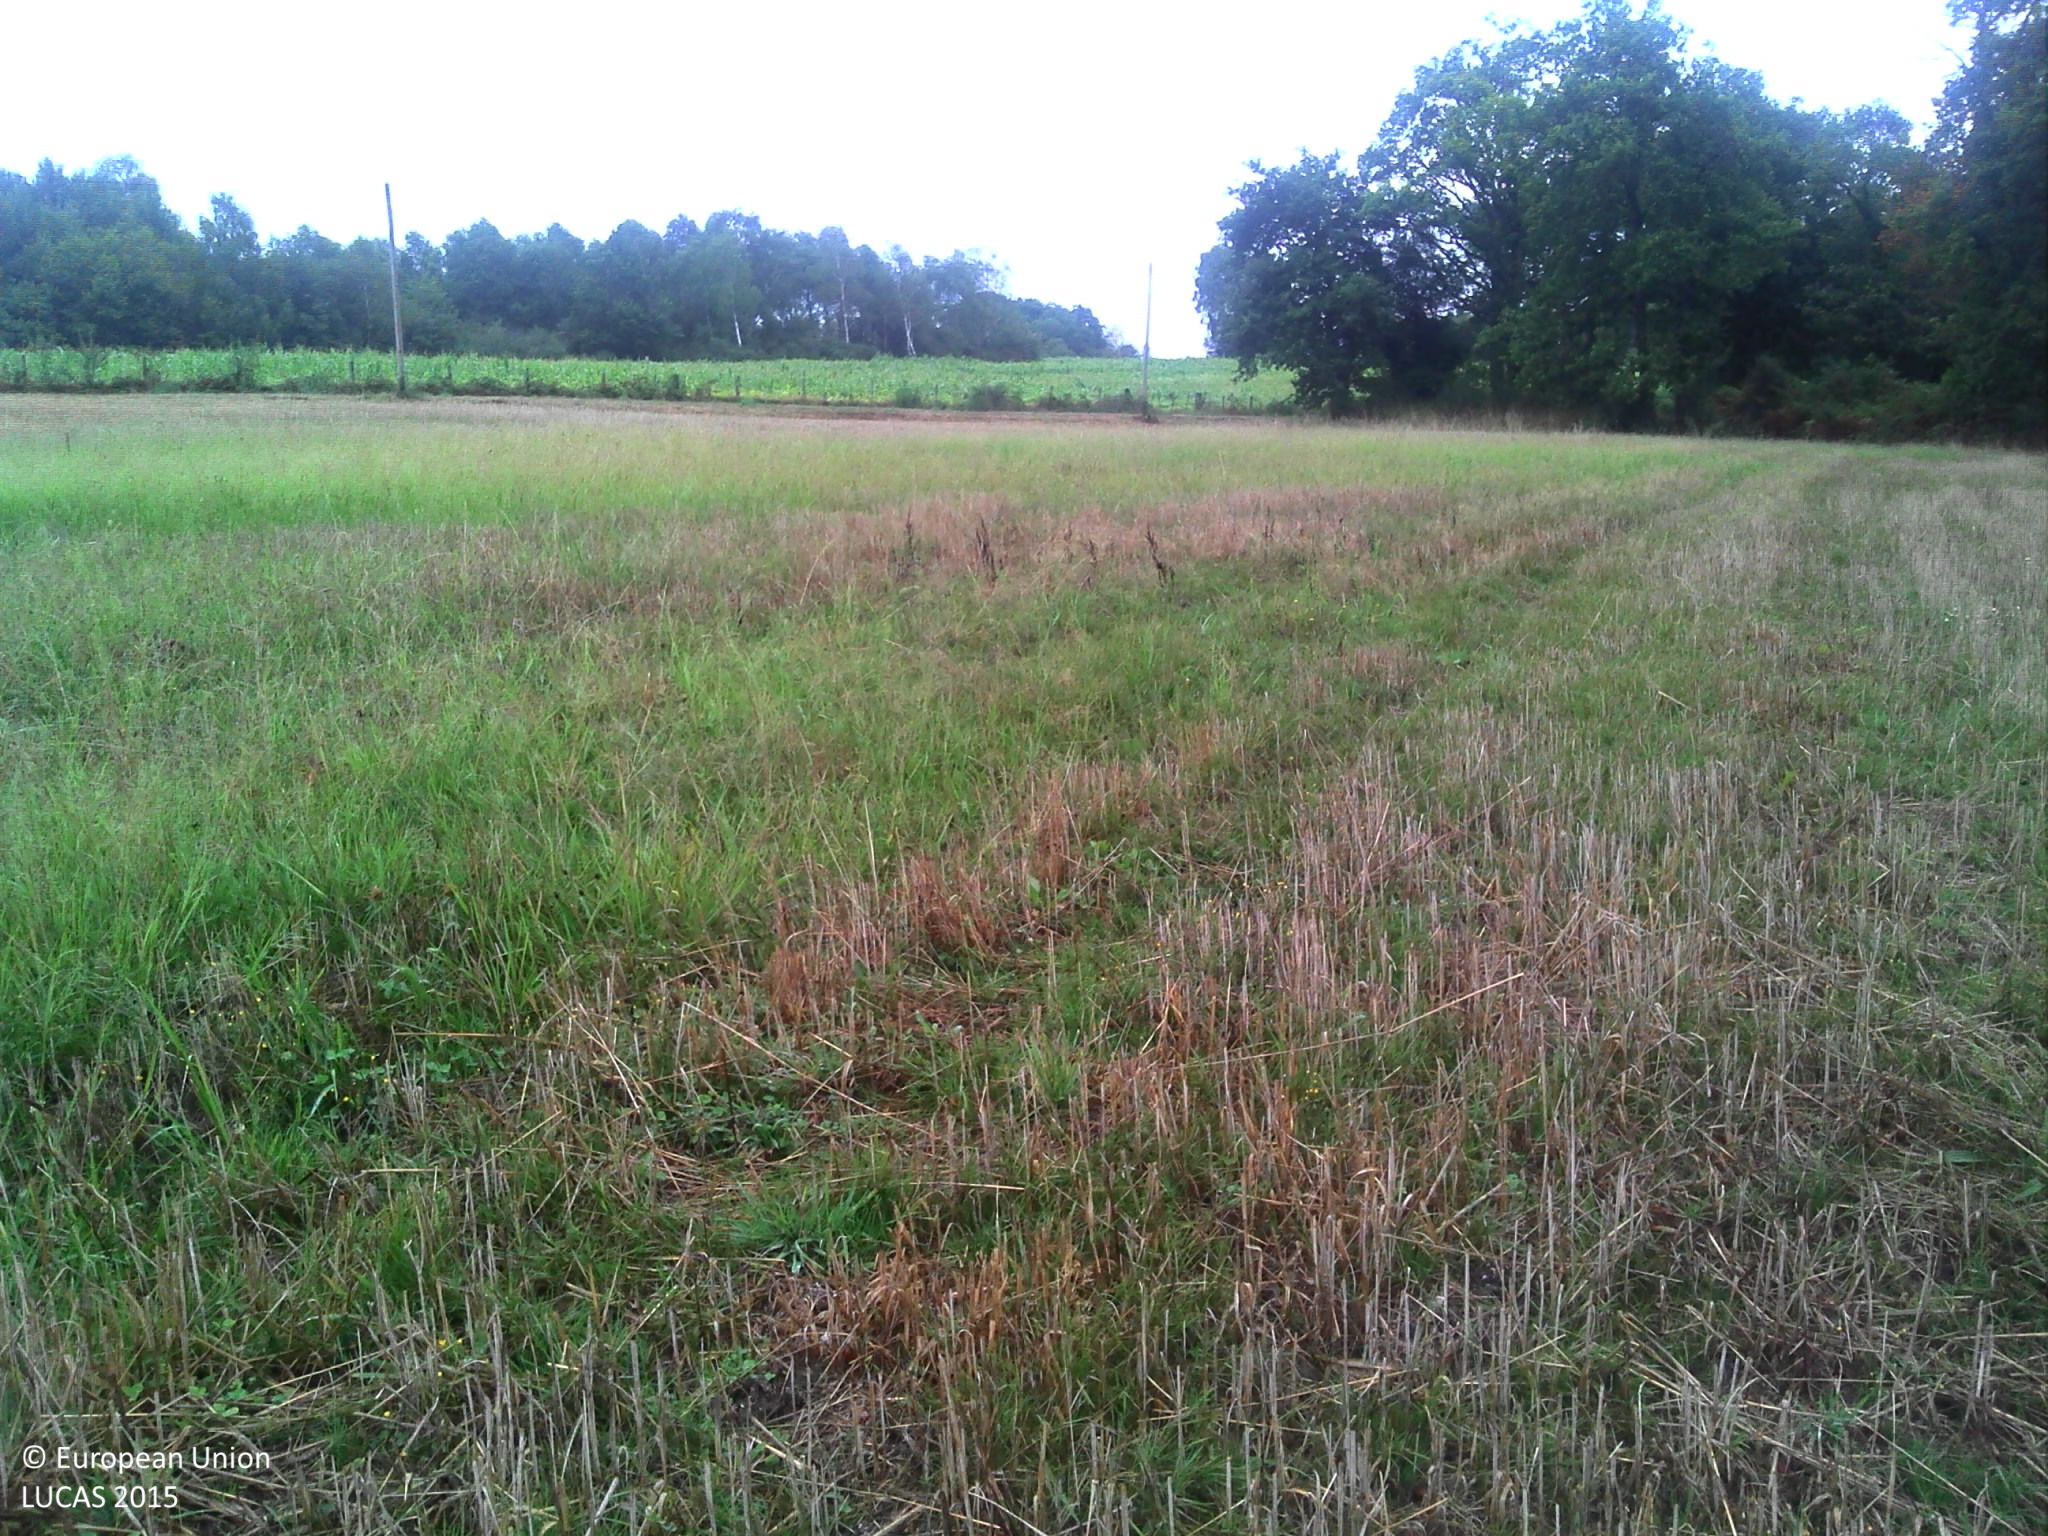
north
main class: Cropland
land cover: Barley
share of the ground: > 75 %
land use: Agriculture (excluding fallow land and kitchen gardens)
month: August
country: FR
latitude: 46.0020
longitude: 0.9360
